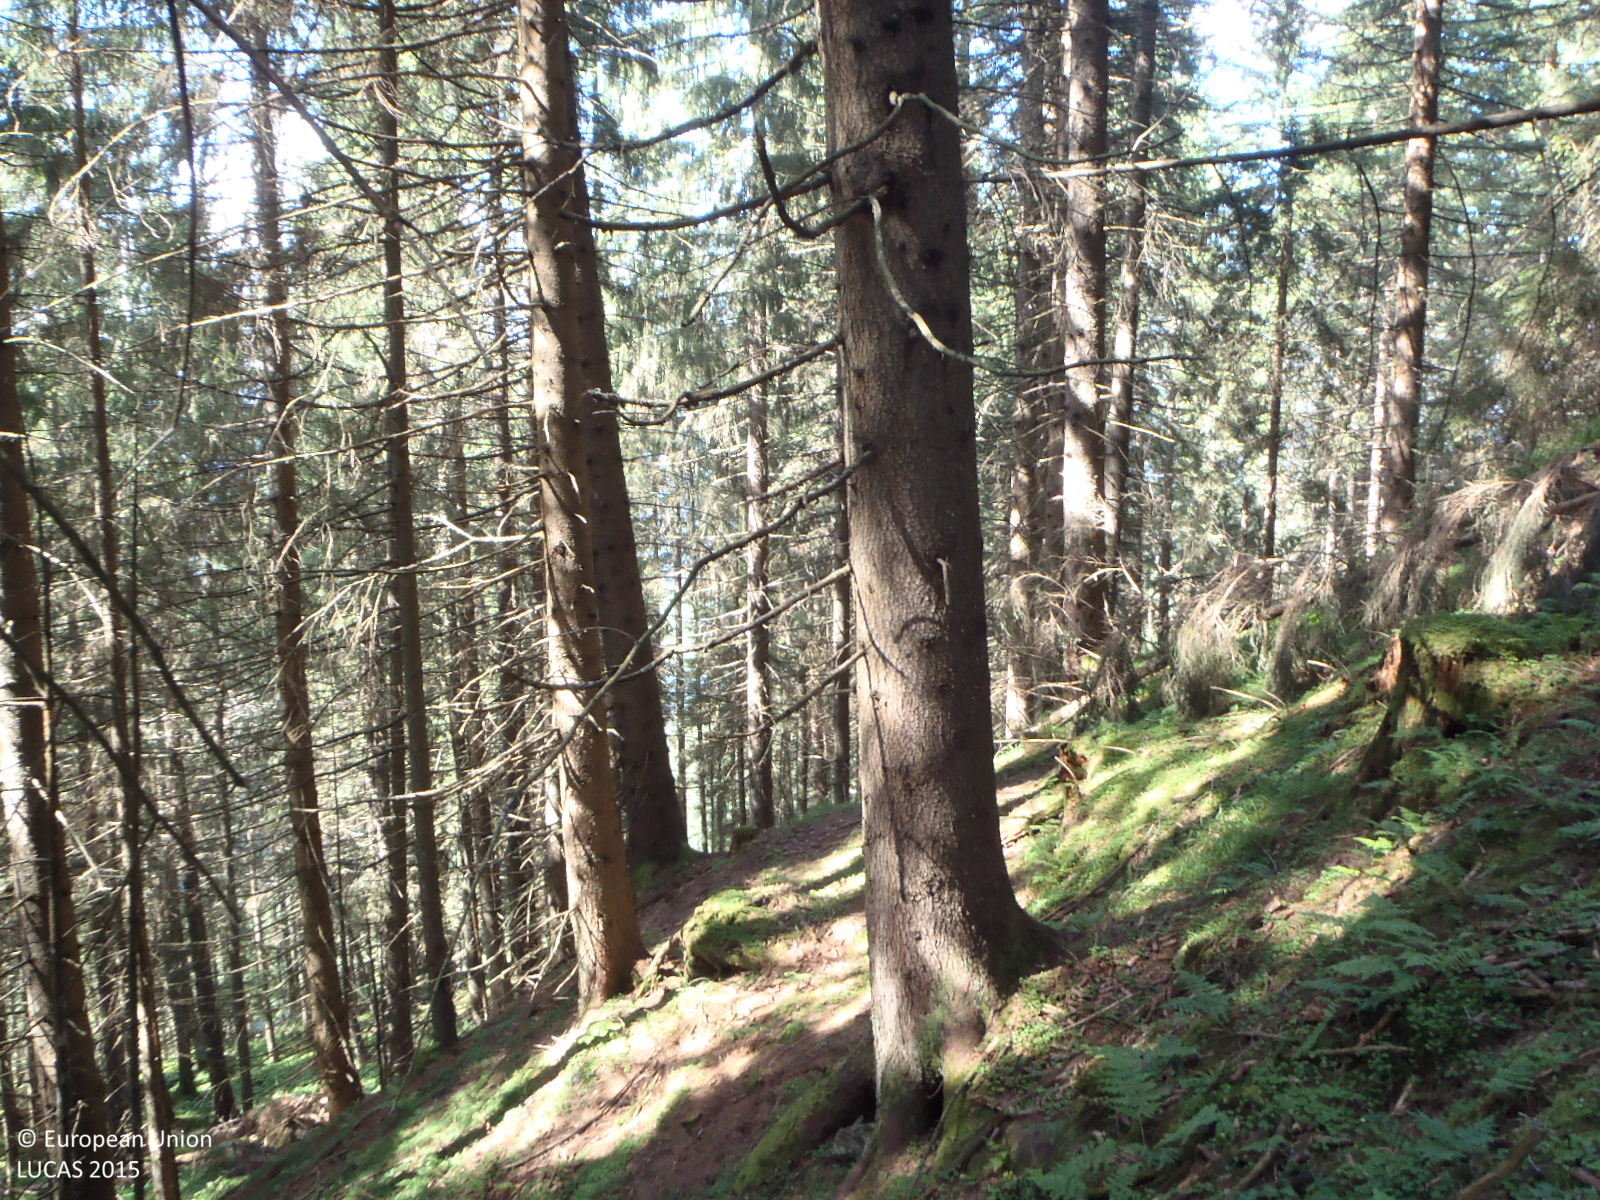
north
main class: Woodland
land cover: Spruce dominated coniferous woodland
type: alpine coniferous forest
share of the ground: > 75 %
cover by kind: coniferous forest trees 80 %, herbaceous plants 10 %, lichens and mosses 10 %
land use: Forestry
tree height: > 5 m
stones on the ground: < 10 %
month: July
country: AT
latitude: 47.3787
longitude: 11.9190
